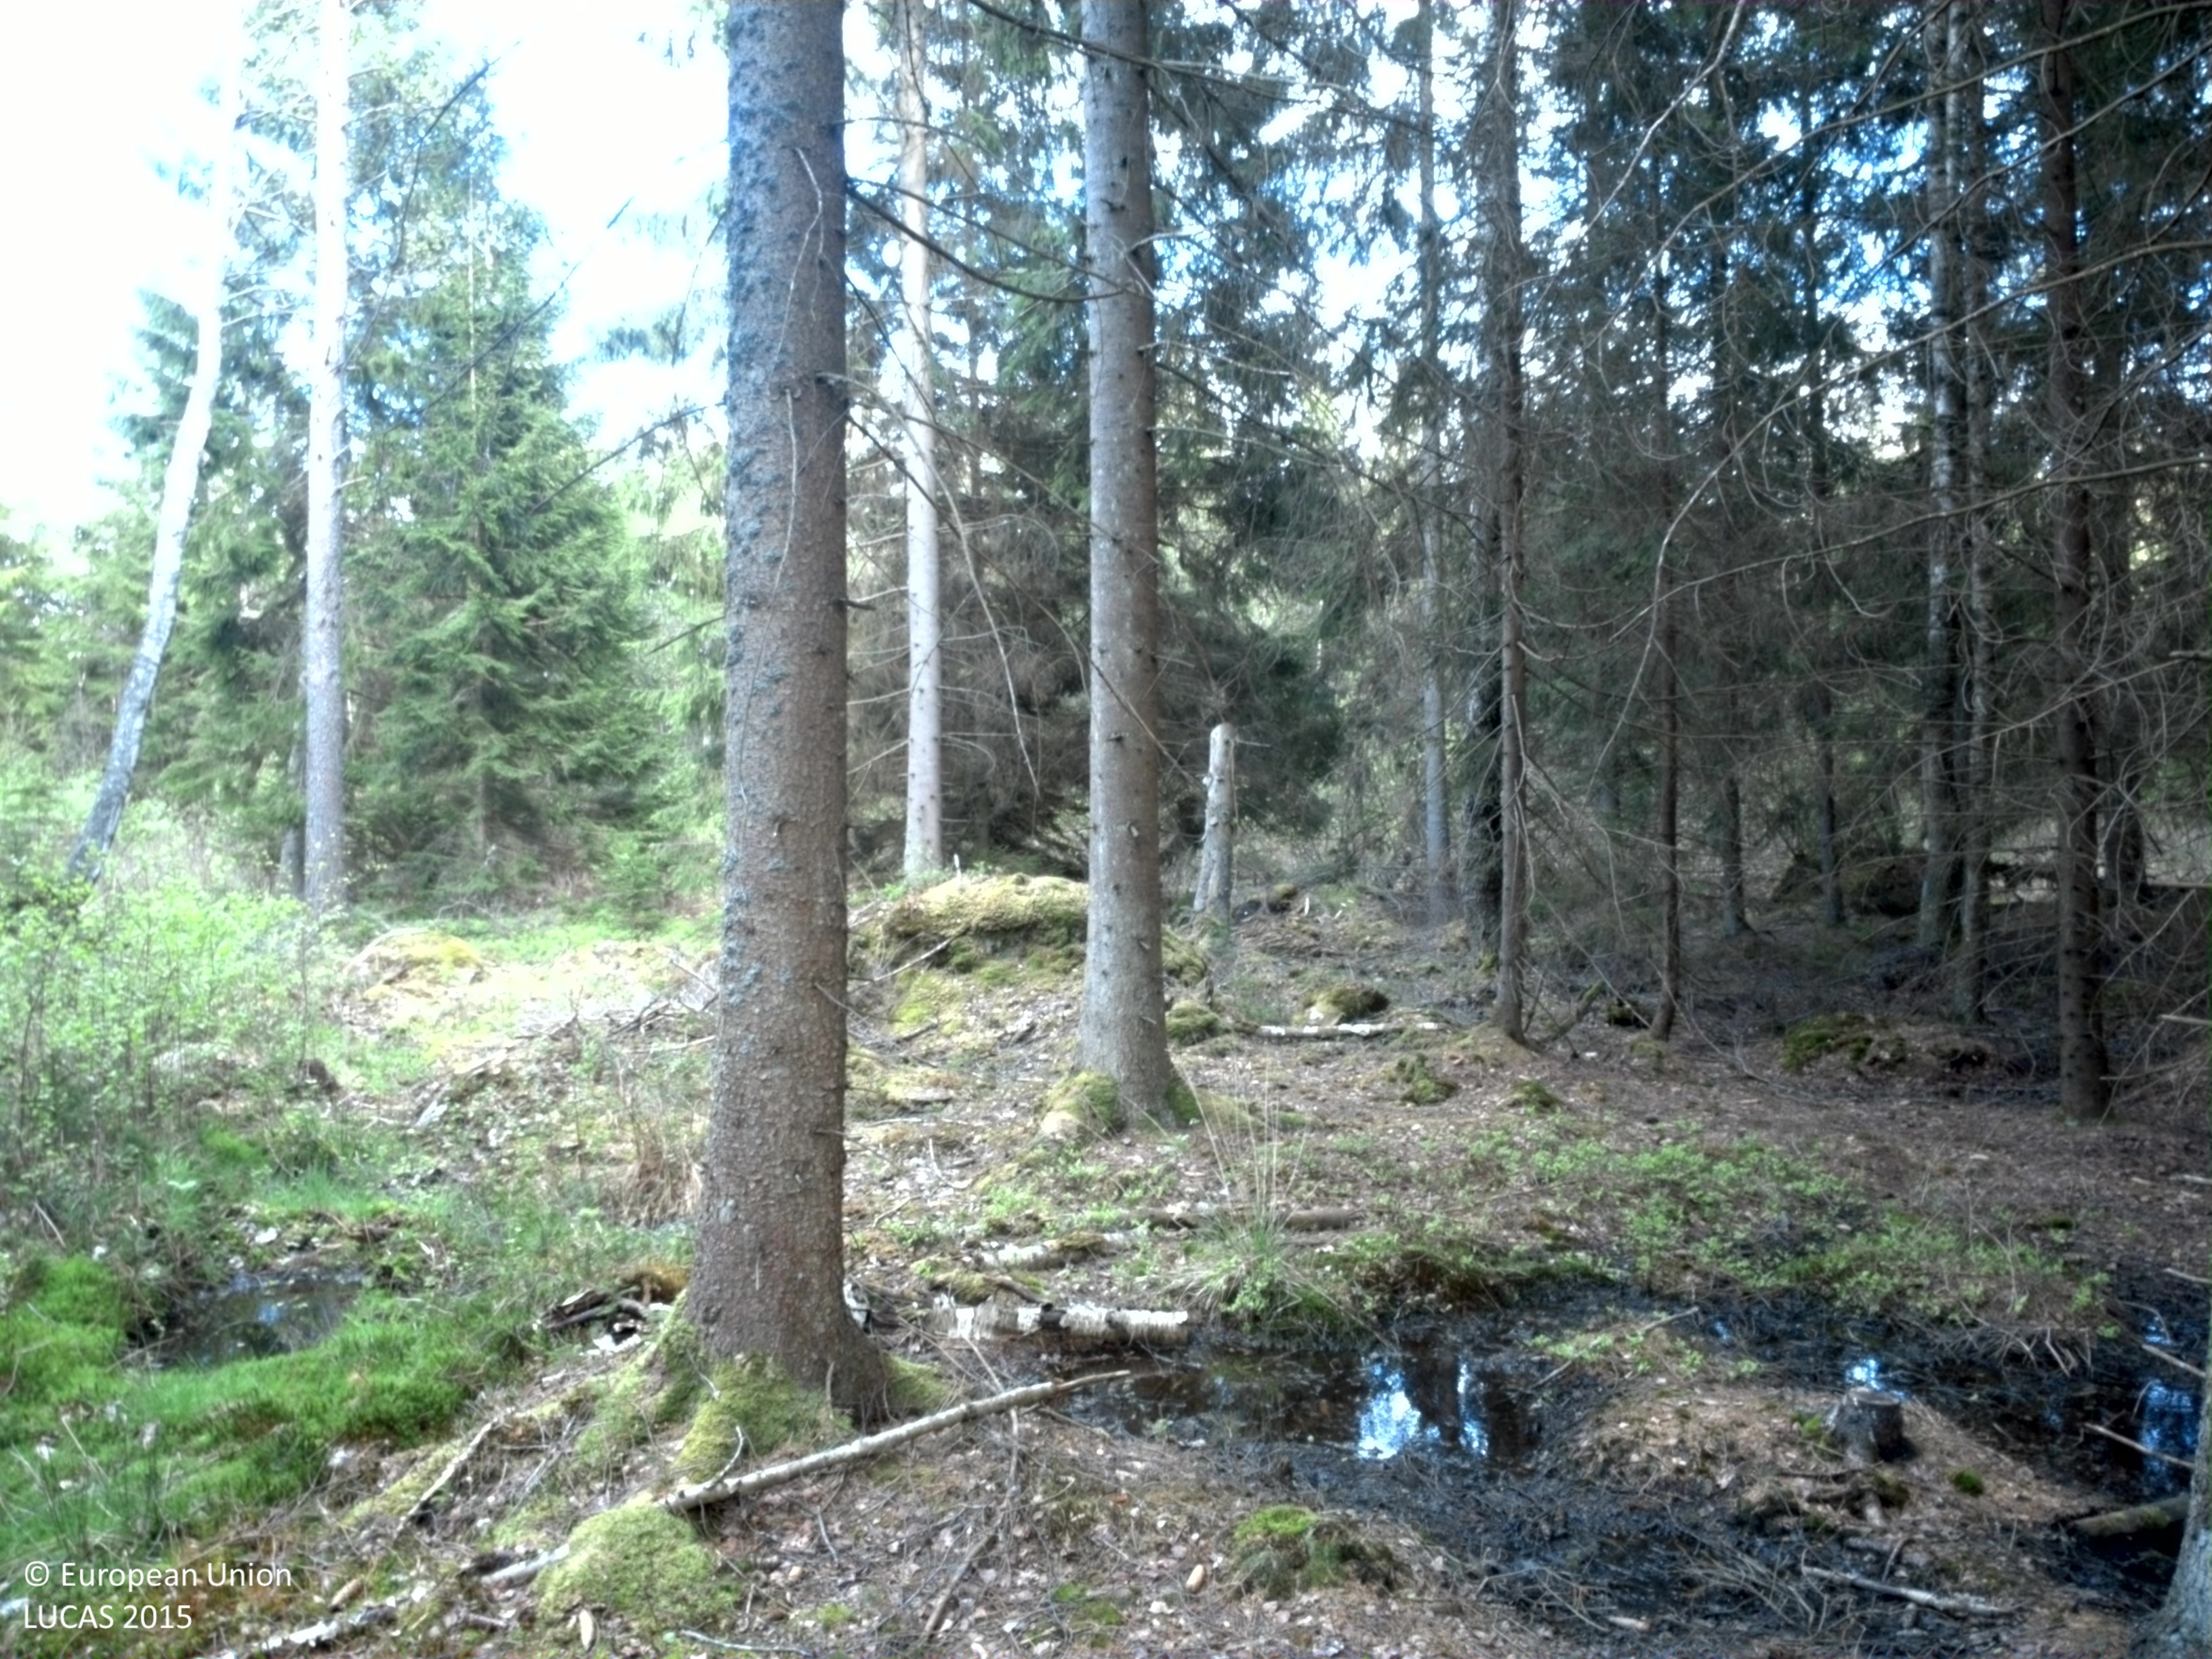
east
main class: Woodland
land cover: Spruce dominated coniferous woodland
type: boreal forest
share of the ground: > 75 %
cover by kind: coniferous forest trees 60 %, broadleaved forest trees 20 %, lichens and mosses 20 %
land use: Forestry
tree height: > 5 m
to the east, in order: Spruce dominated coniferous woodland; Broadleaved woodland; Spruce dominated coniferous woodland; Dry stone walls; Spruce dominated coniferous woodland
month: May
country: SE
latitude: 56.6464
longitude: 14.5799
